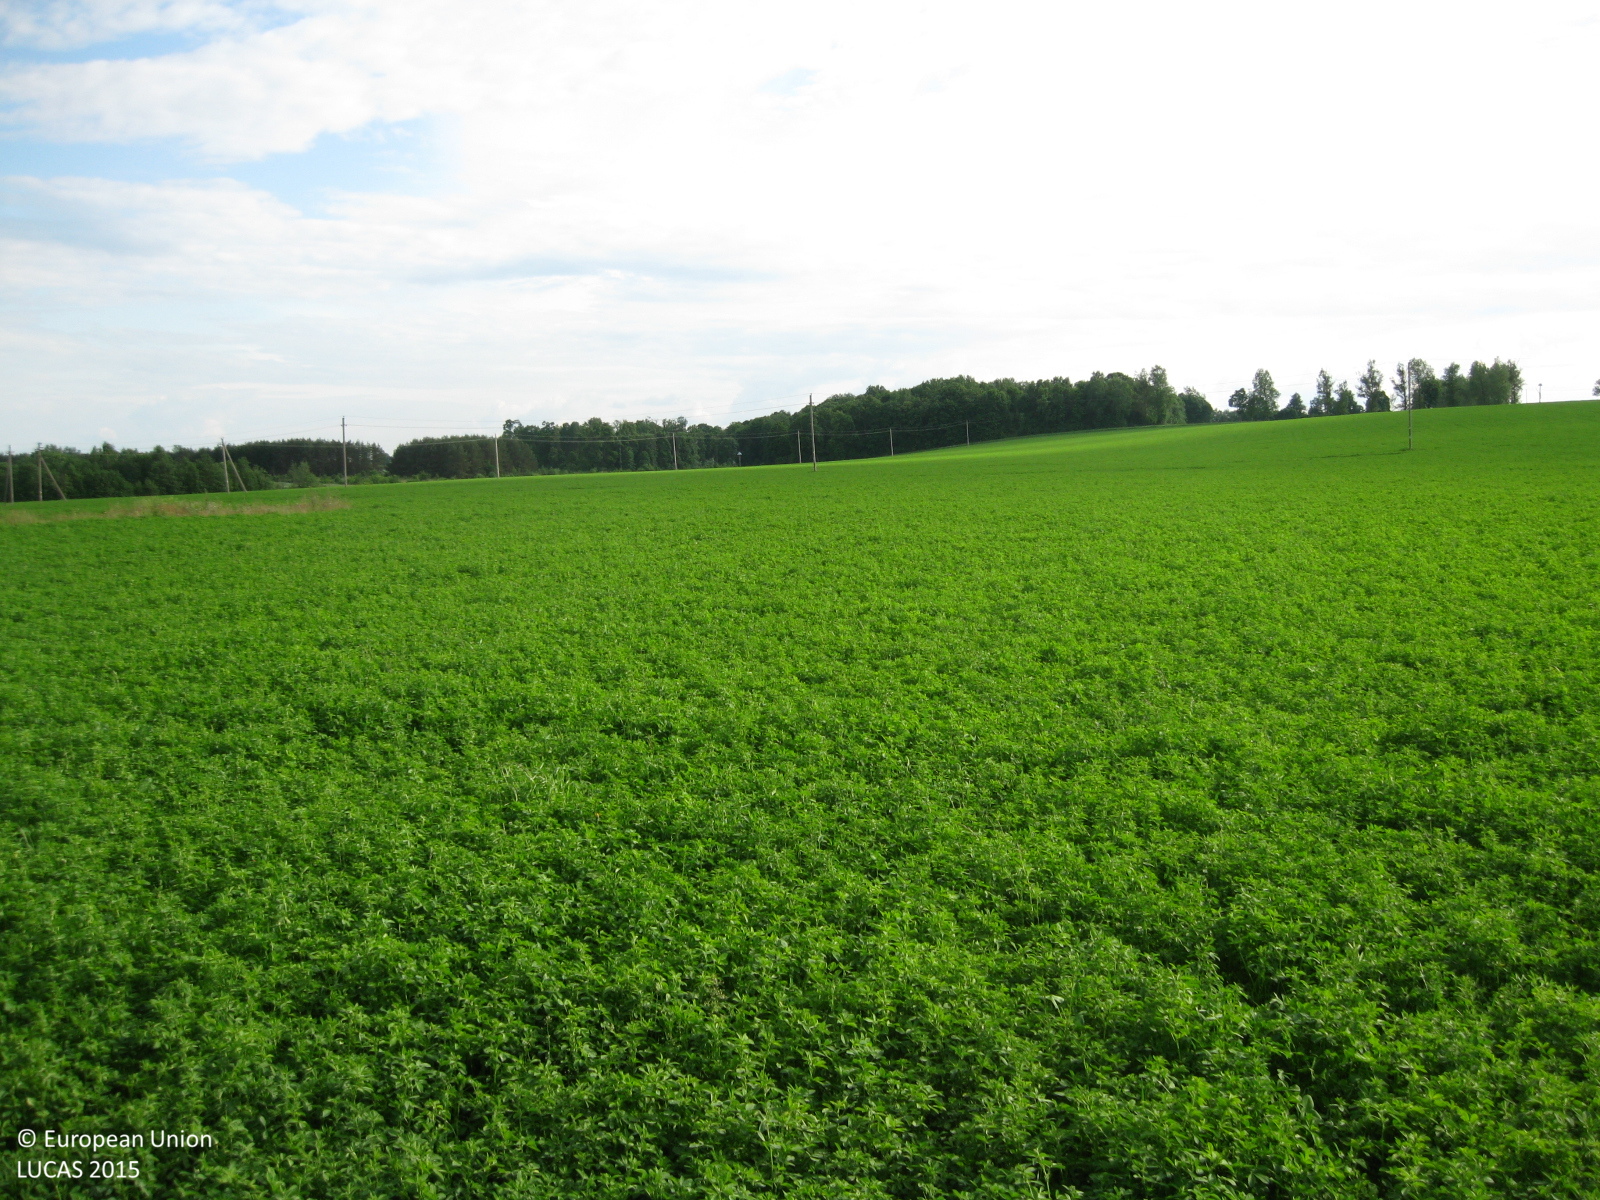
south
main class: Cropland
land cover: Clovers
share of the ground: > 75 %
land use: Agriculture (excluding fallow land and kitchen gardens)
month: June
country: LT
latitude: 55.1892
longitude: 23.8945
